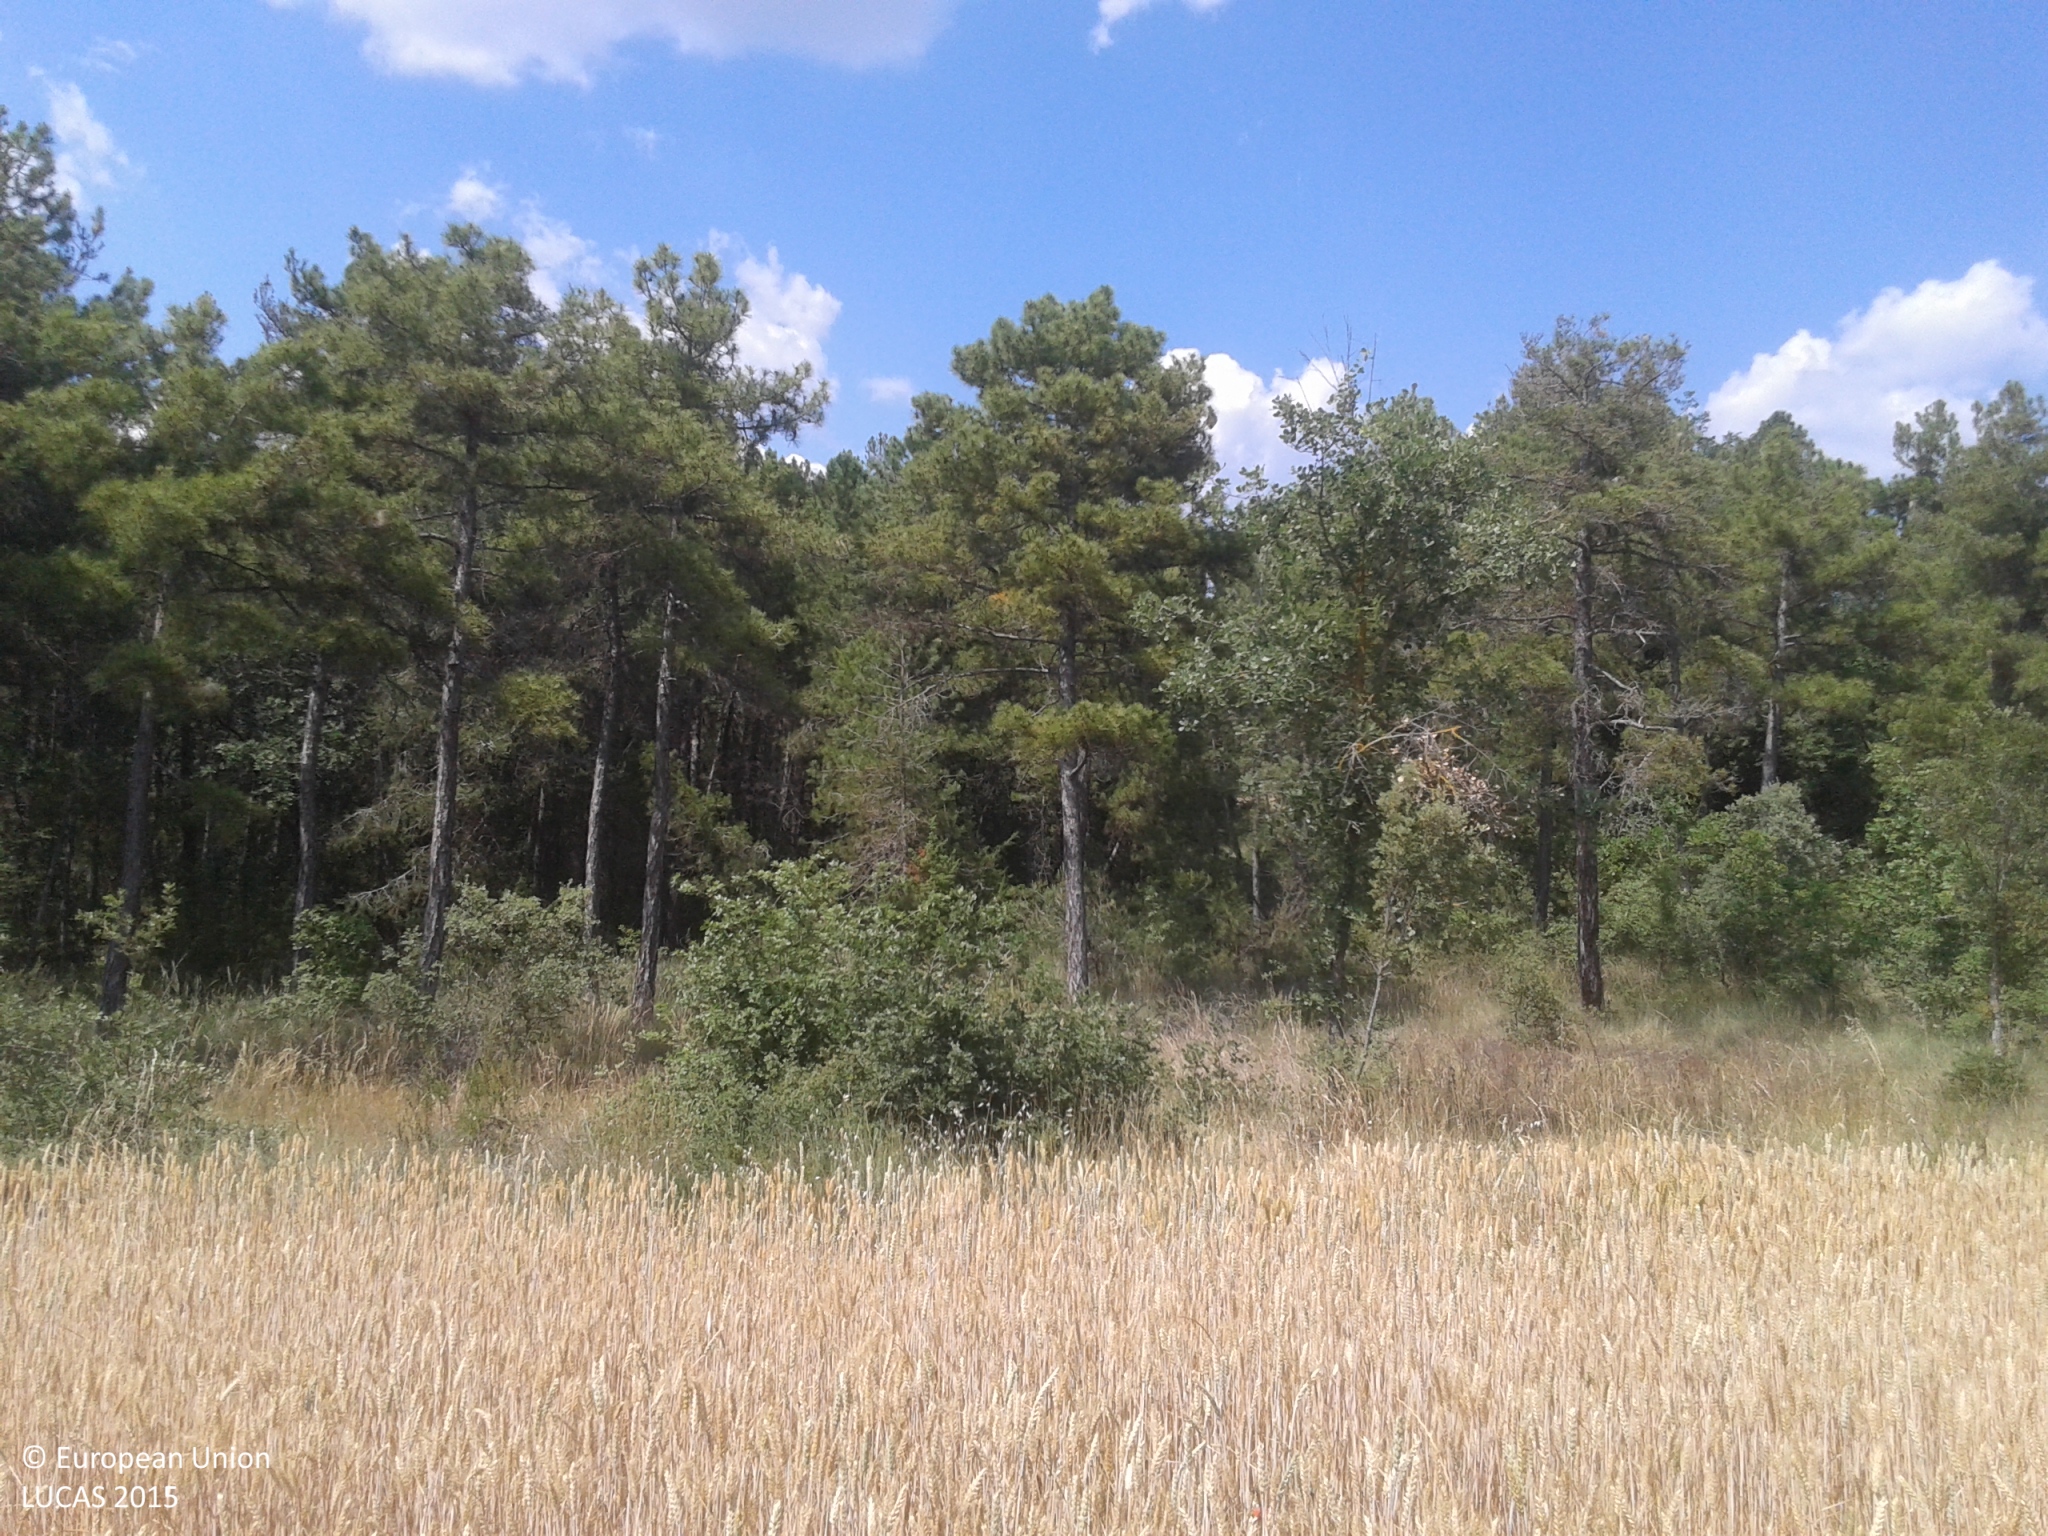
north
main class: Cropland
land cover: Common wheat
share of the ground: > 75 %
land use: Agriculture (excluding fallow land and kitchen gardens)
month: June
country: ES
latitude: 41.9580
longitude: 1.5796
